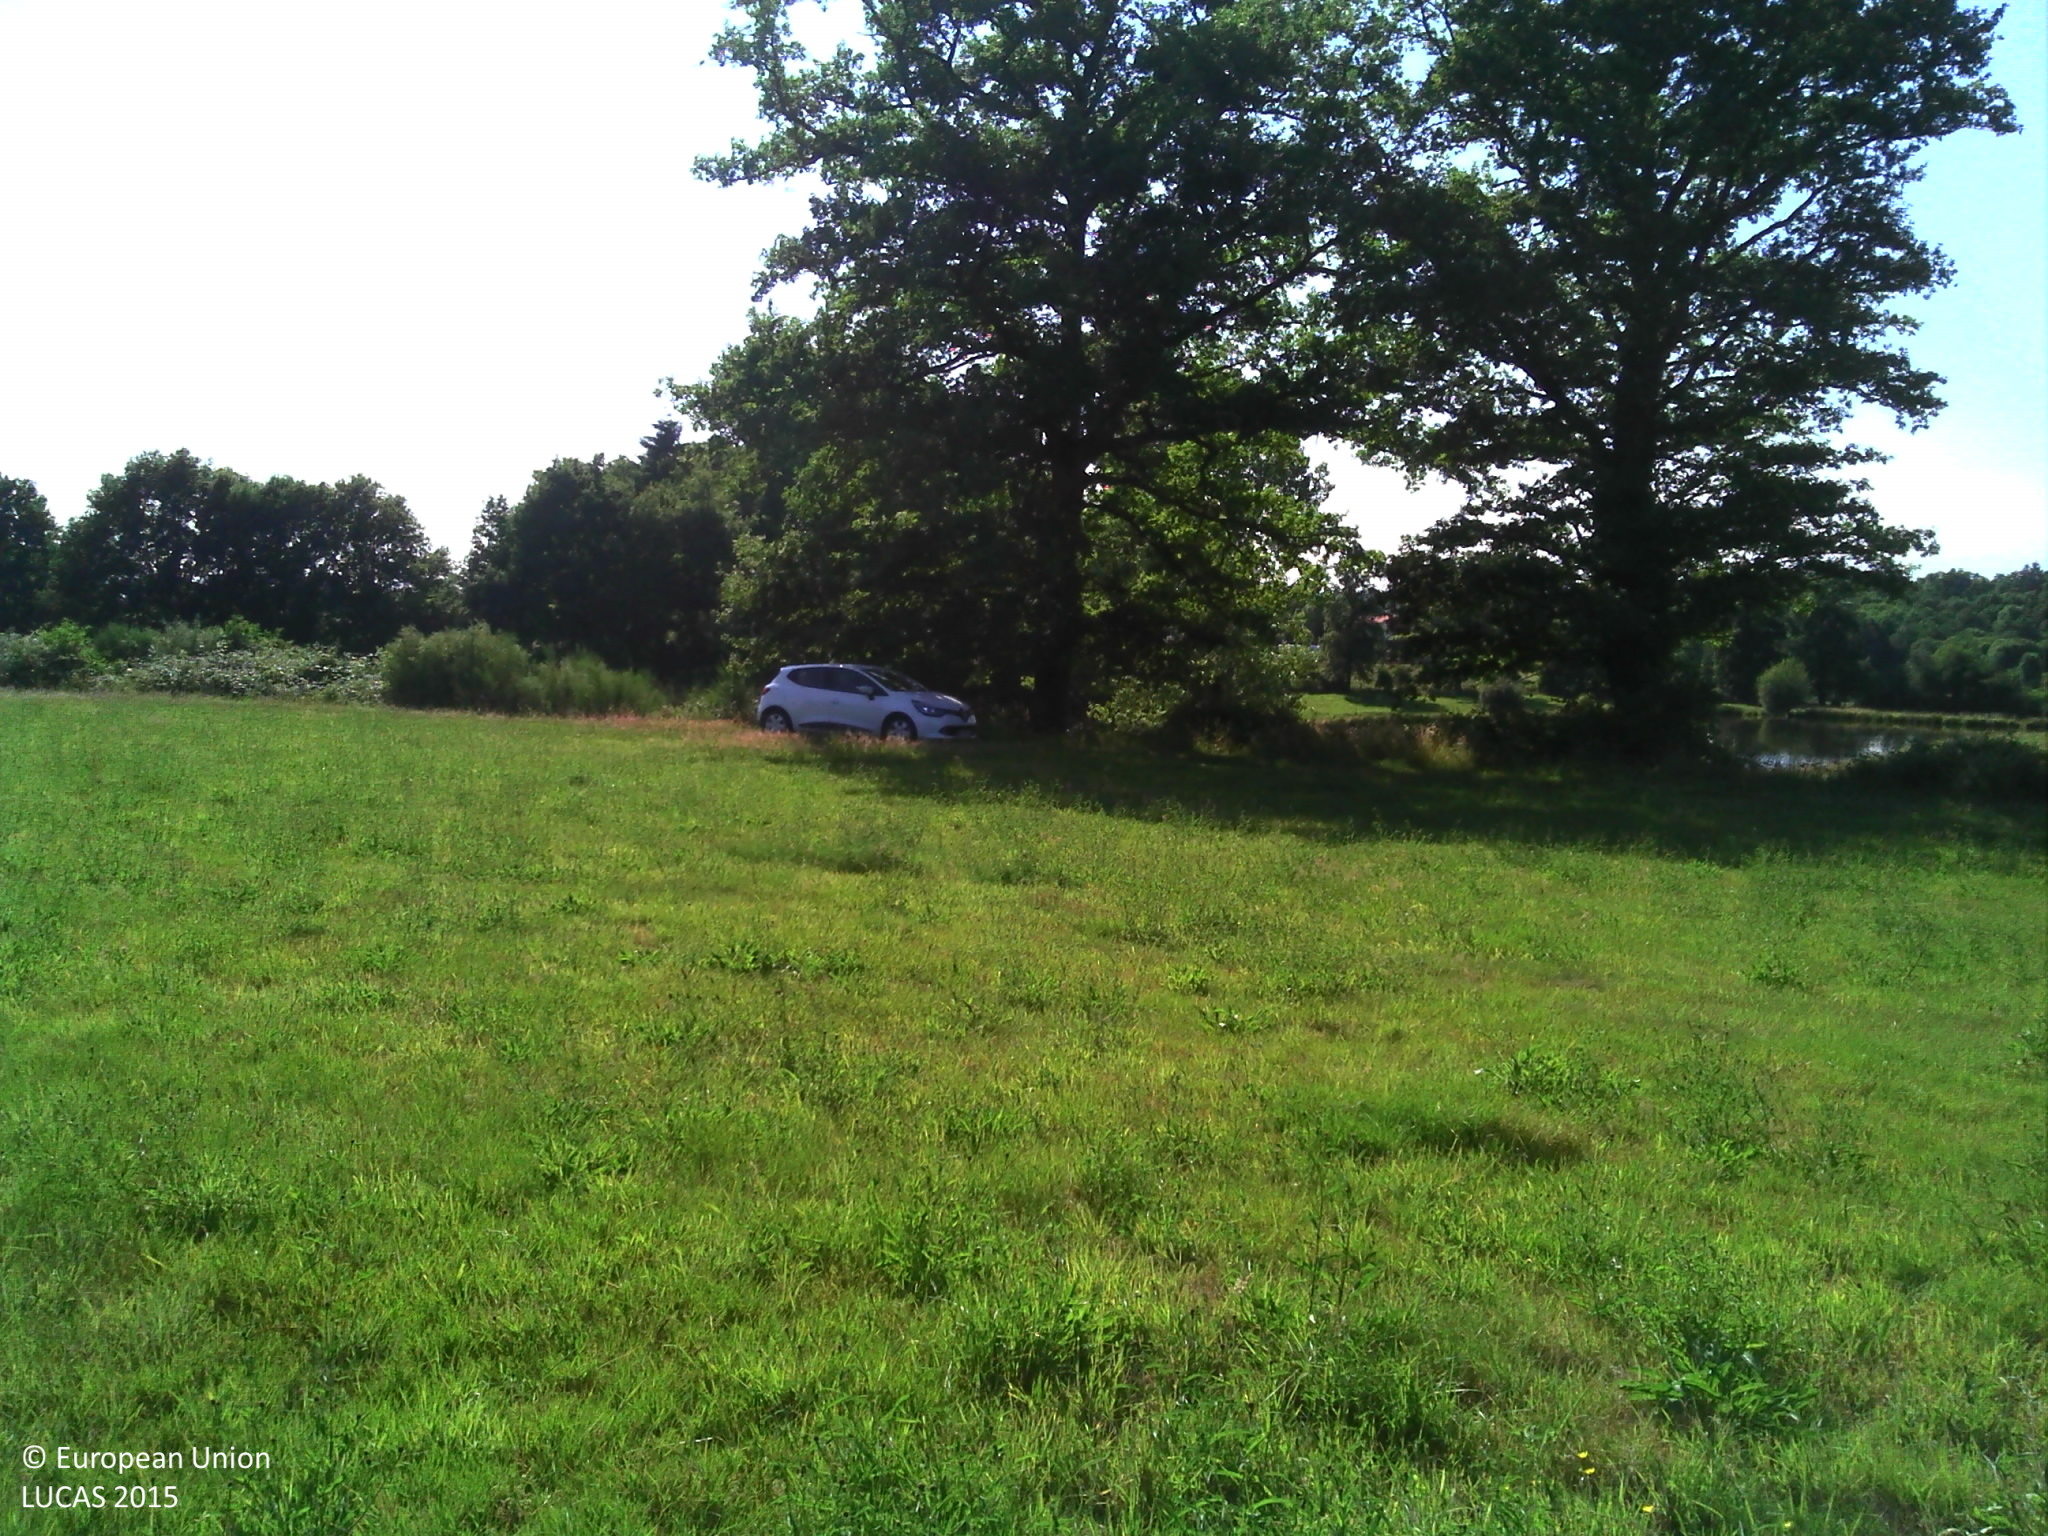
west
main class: Grassland
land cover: Grassland without tree/shrub cover
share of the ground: > 75 %
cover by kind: herbaceous plants 100 %
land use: Agriculture (excluding fallow land and kitchen gardens)
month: June
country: FR
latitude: 45.7564
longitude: 0.6146
